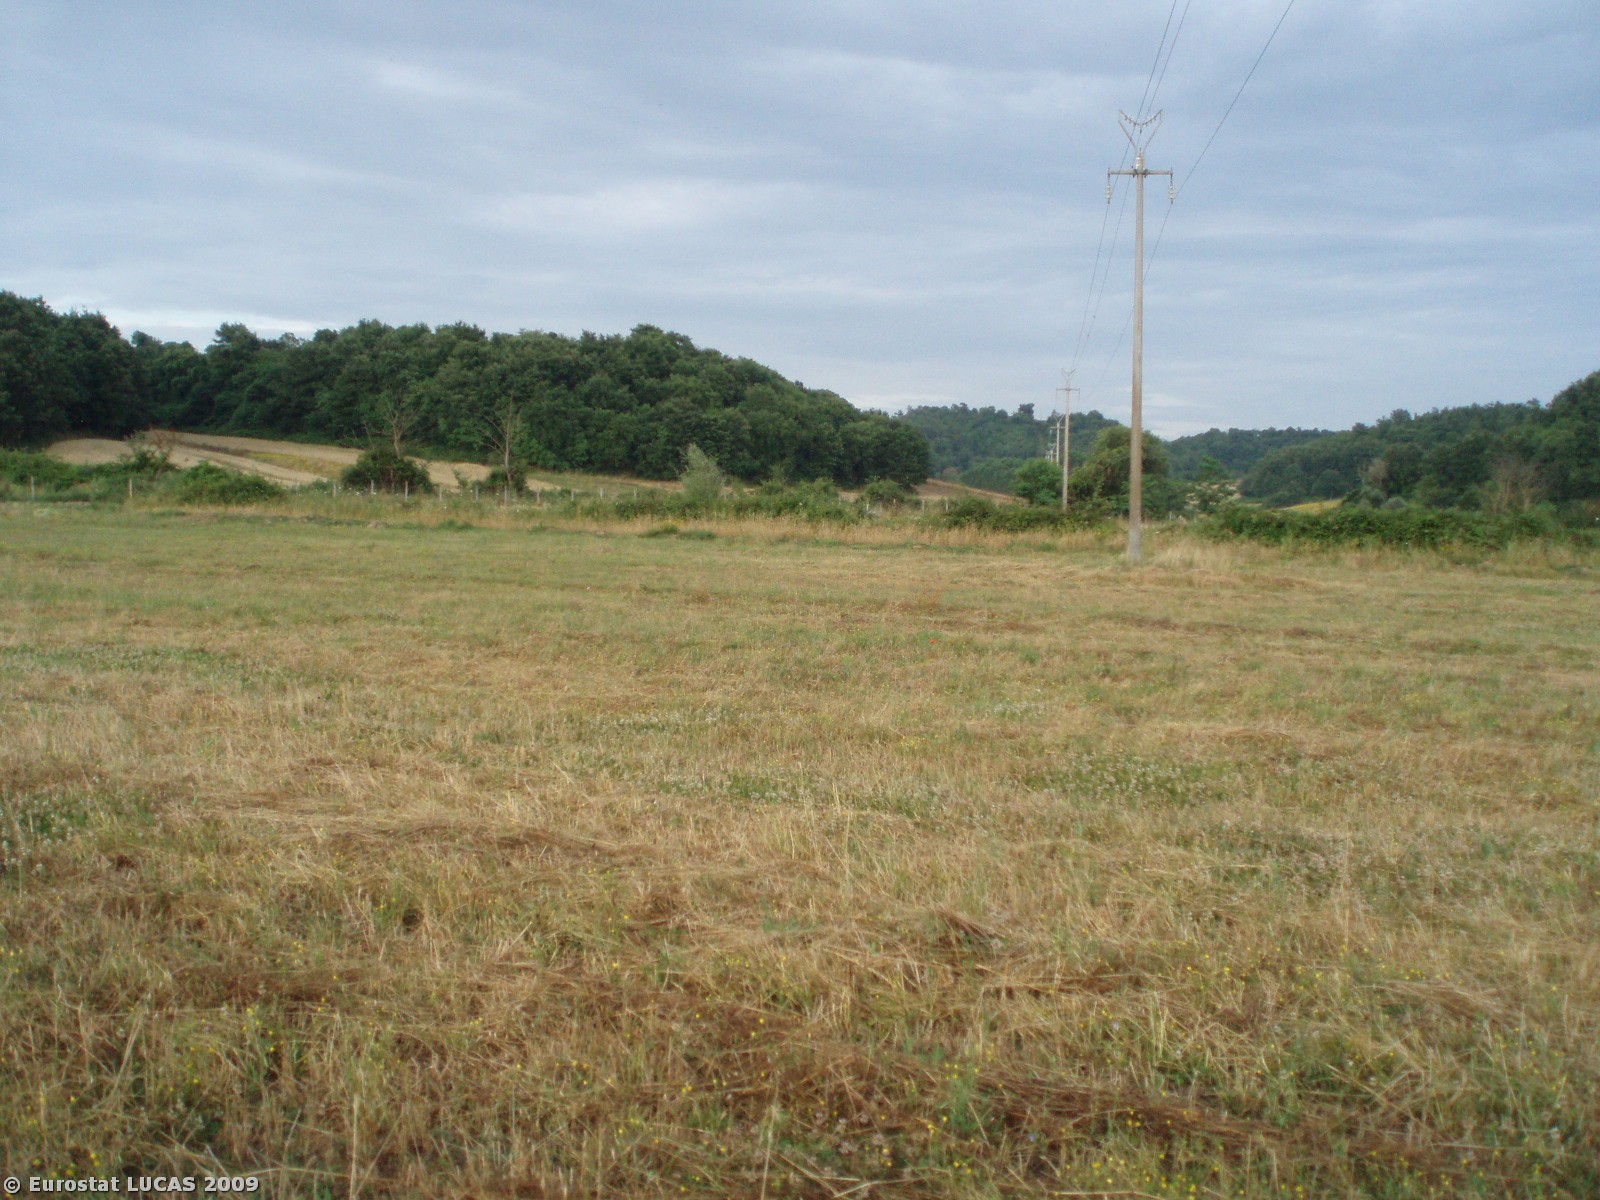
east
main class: Grassland
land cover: Grassland without tree/shrub cover
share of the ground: > 75 %
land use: Agriculture (excluding fallow land and kitchen gardens)
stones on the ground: < 10 %
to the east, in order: Grassland without tree/shrub cover; Electric lines; Grassland without tree/shrub cover; Grass margins; Ditches and canals; Grass margins; Barley; Fences; Grass margins; Tracks; Ditches and canals; Fences; Abandoned hedges; Barley
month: June
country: IT
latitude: 42.6054
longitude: 11.5914
